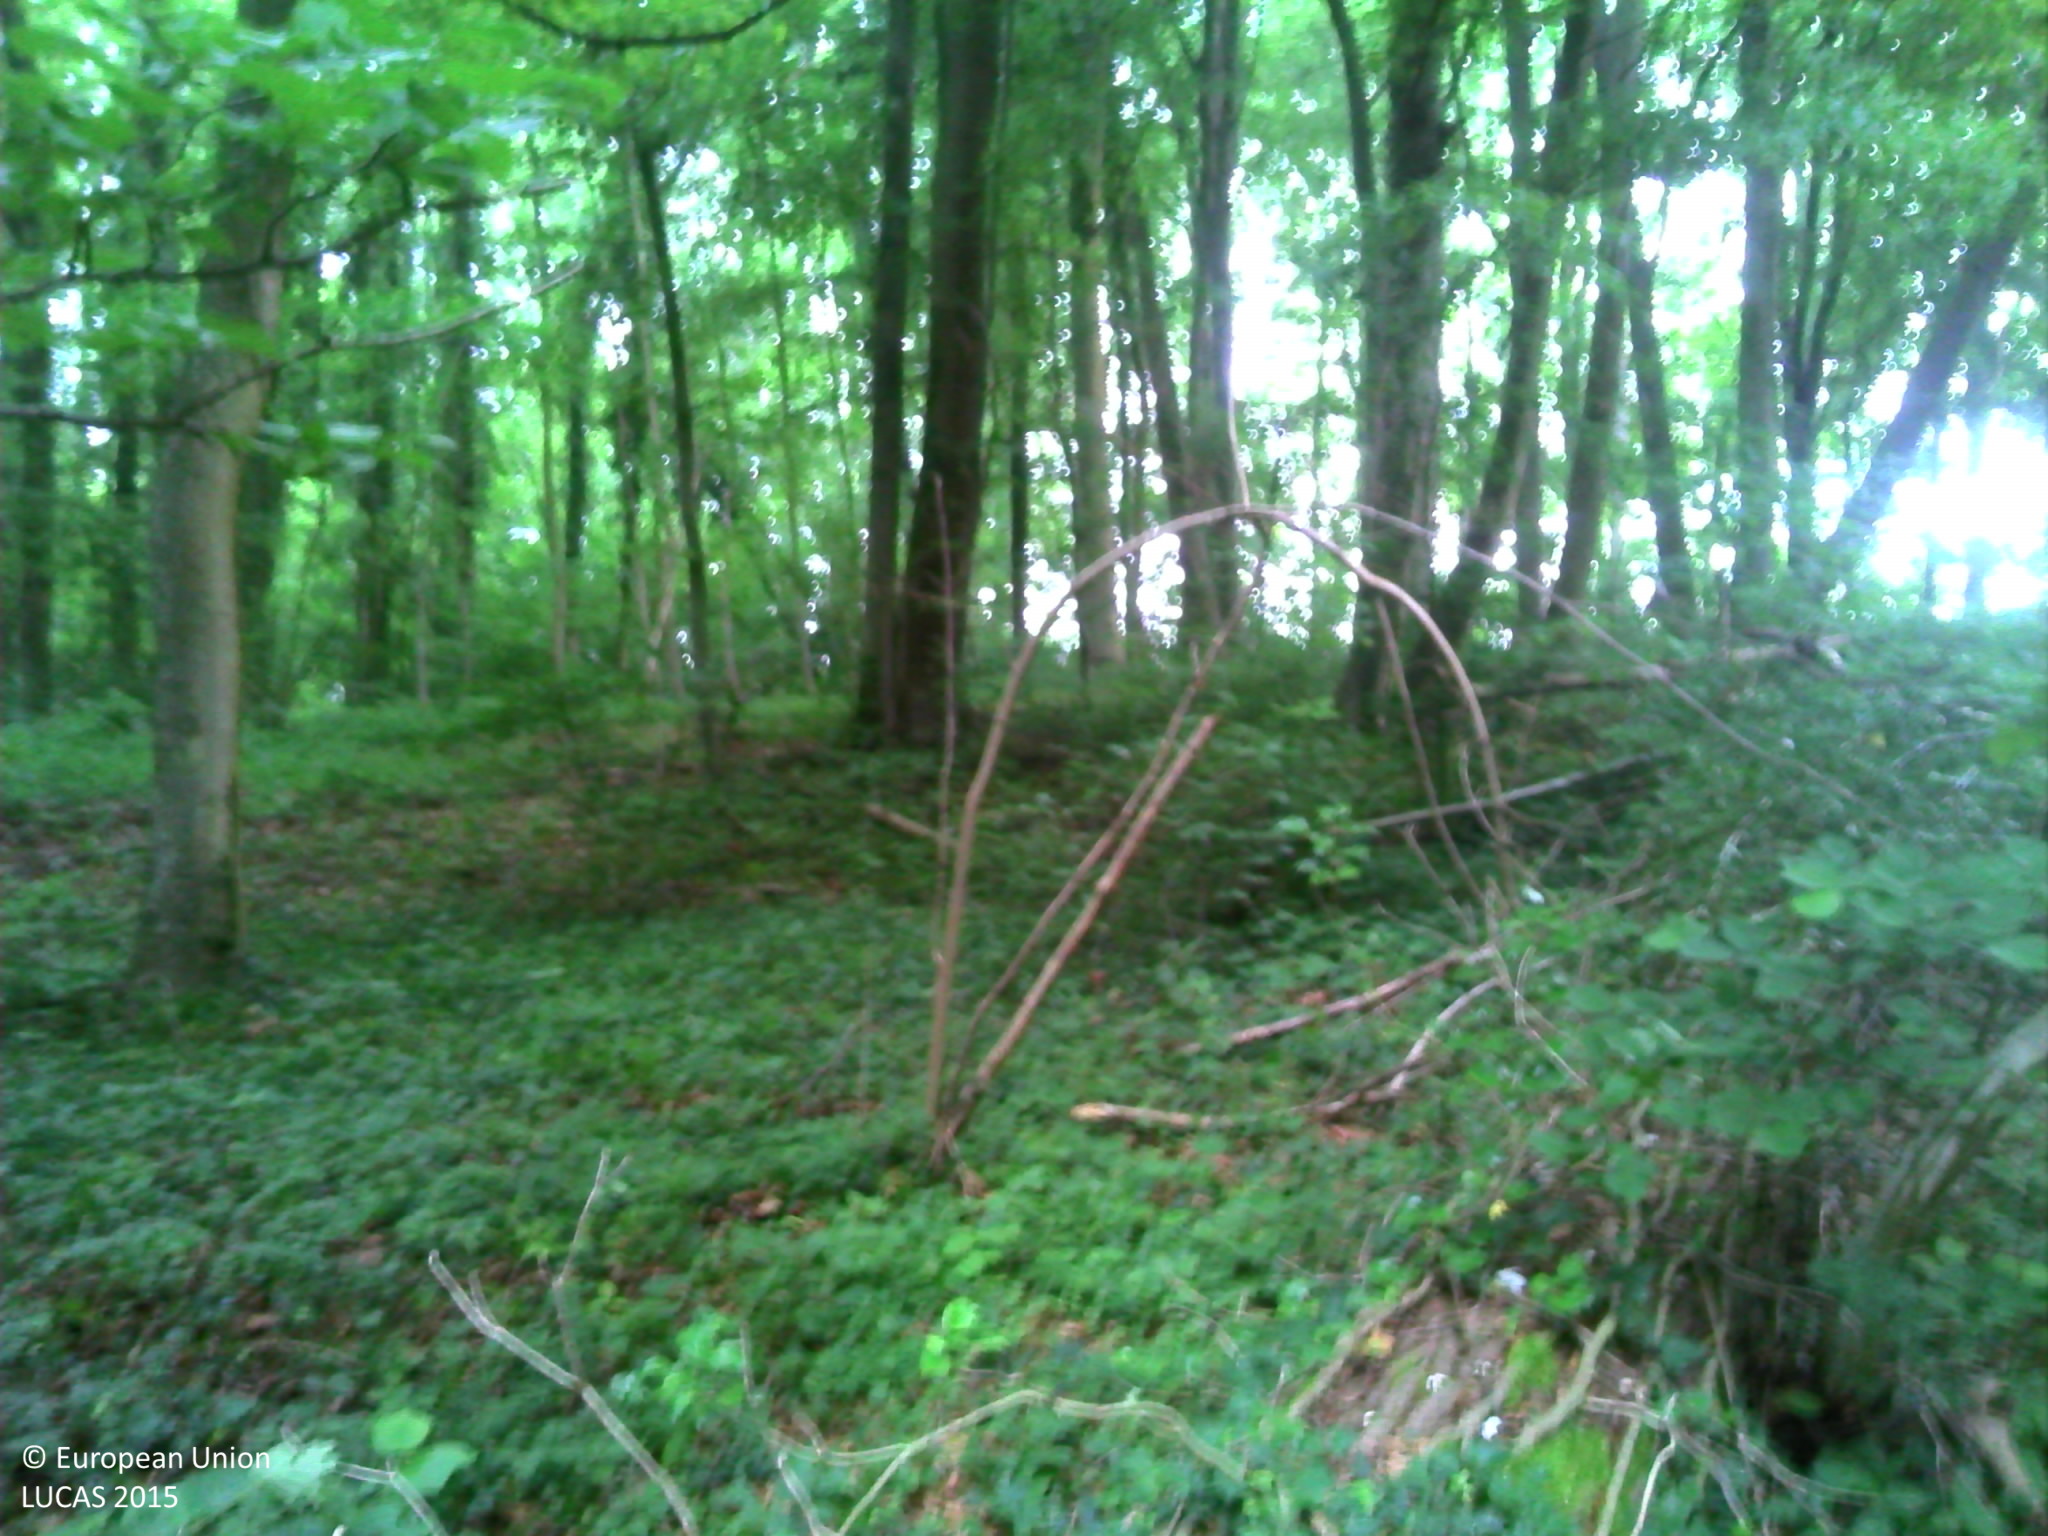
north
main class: Woodland
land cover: Broadleaved woodland
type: beech forest
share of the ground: > 75 %
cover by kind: broadleaved forest trees 95 %, herbaceous plants 5 %
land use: Forestry
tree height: > 5 m
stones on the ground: < 10 %
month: June
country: FR
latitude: 47.6162
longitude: 7.3806
